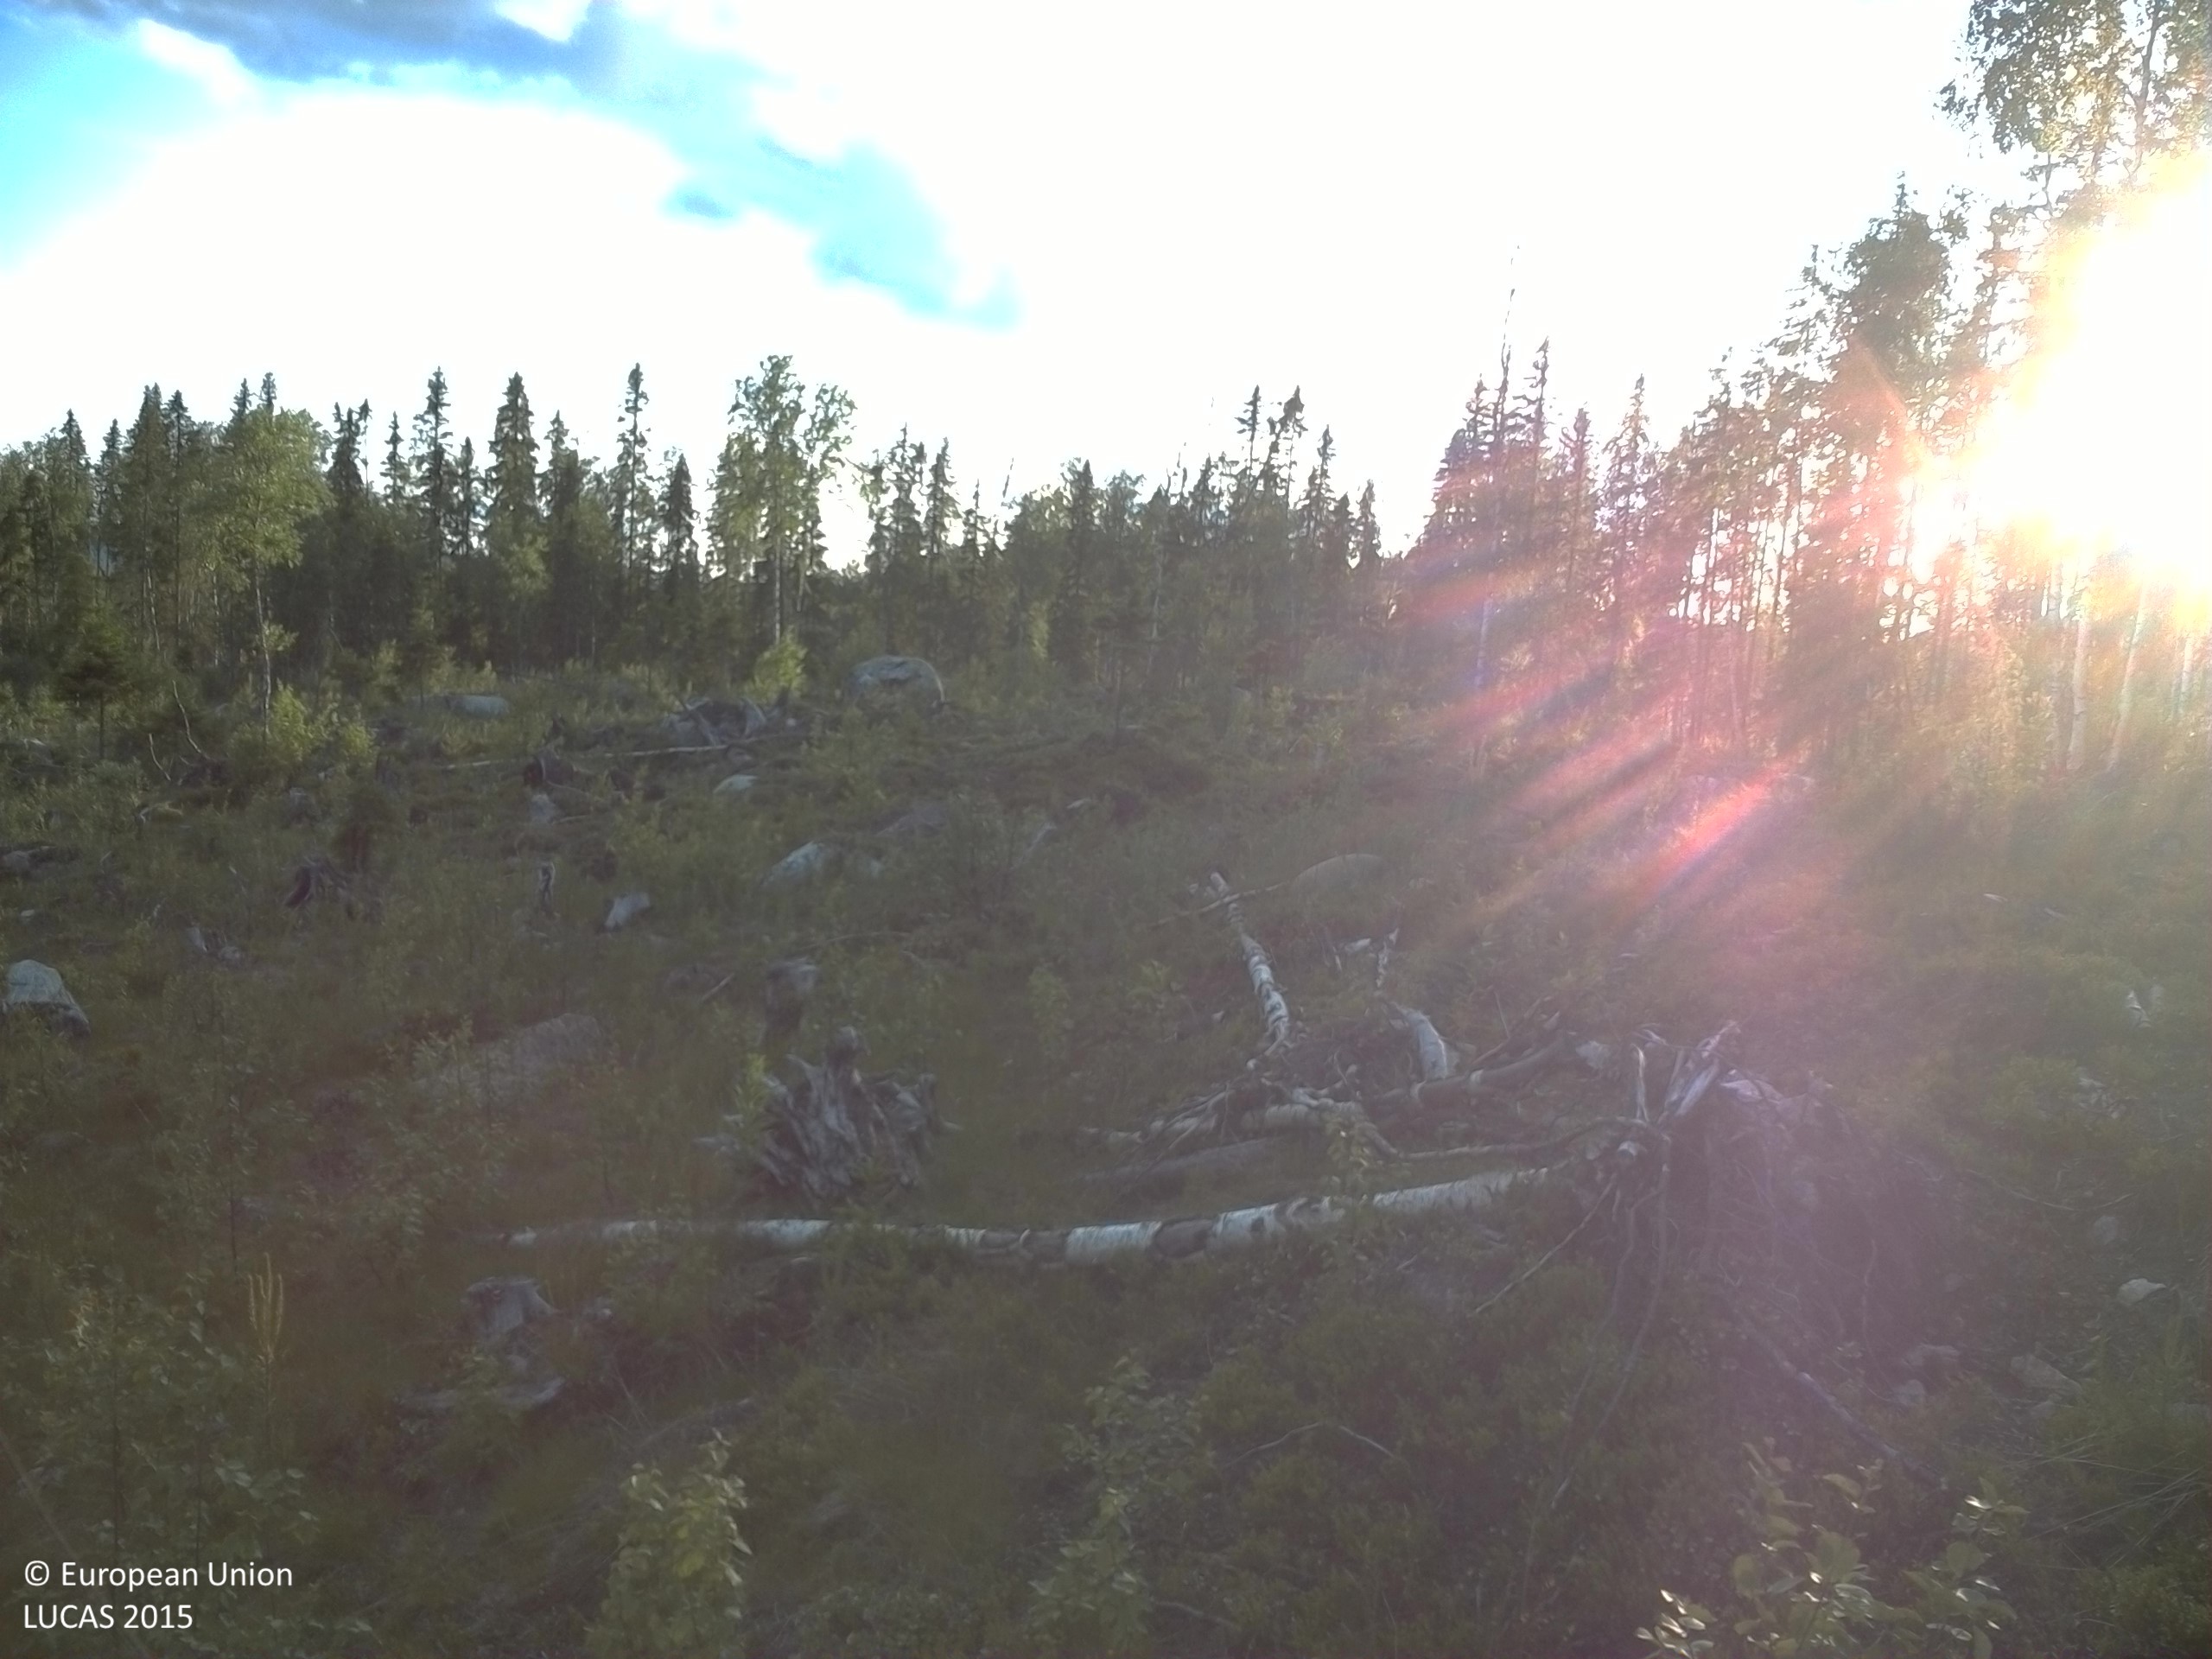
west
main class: Woodland
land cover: Pine dominated mixed woodland
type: boreal forest
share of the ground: 10 - 25 %
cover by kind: herbaceous plants 30 %, shrubs 20 %, lichens and mosses 15 %, consolidated bare surface 15 %, coniferous forest trees 10 %, broadleaved forest trees 5 %, unconsolidated bare surface 5 %
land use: Forestry
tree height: < 5 m
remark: Clear cut
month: July
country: SE
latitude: 64.3183
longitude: 16.5249
